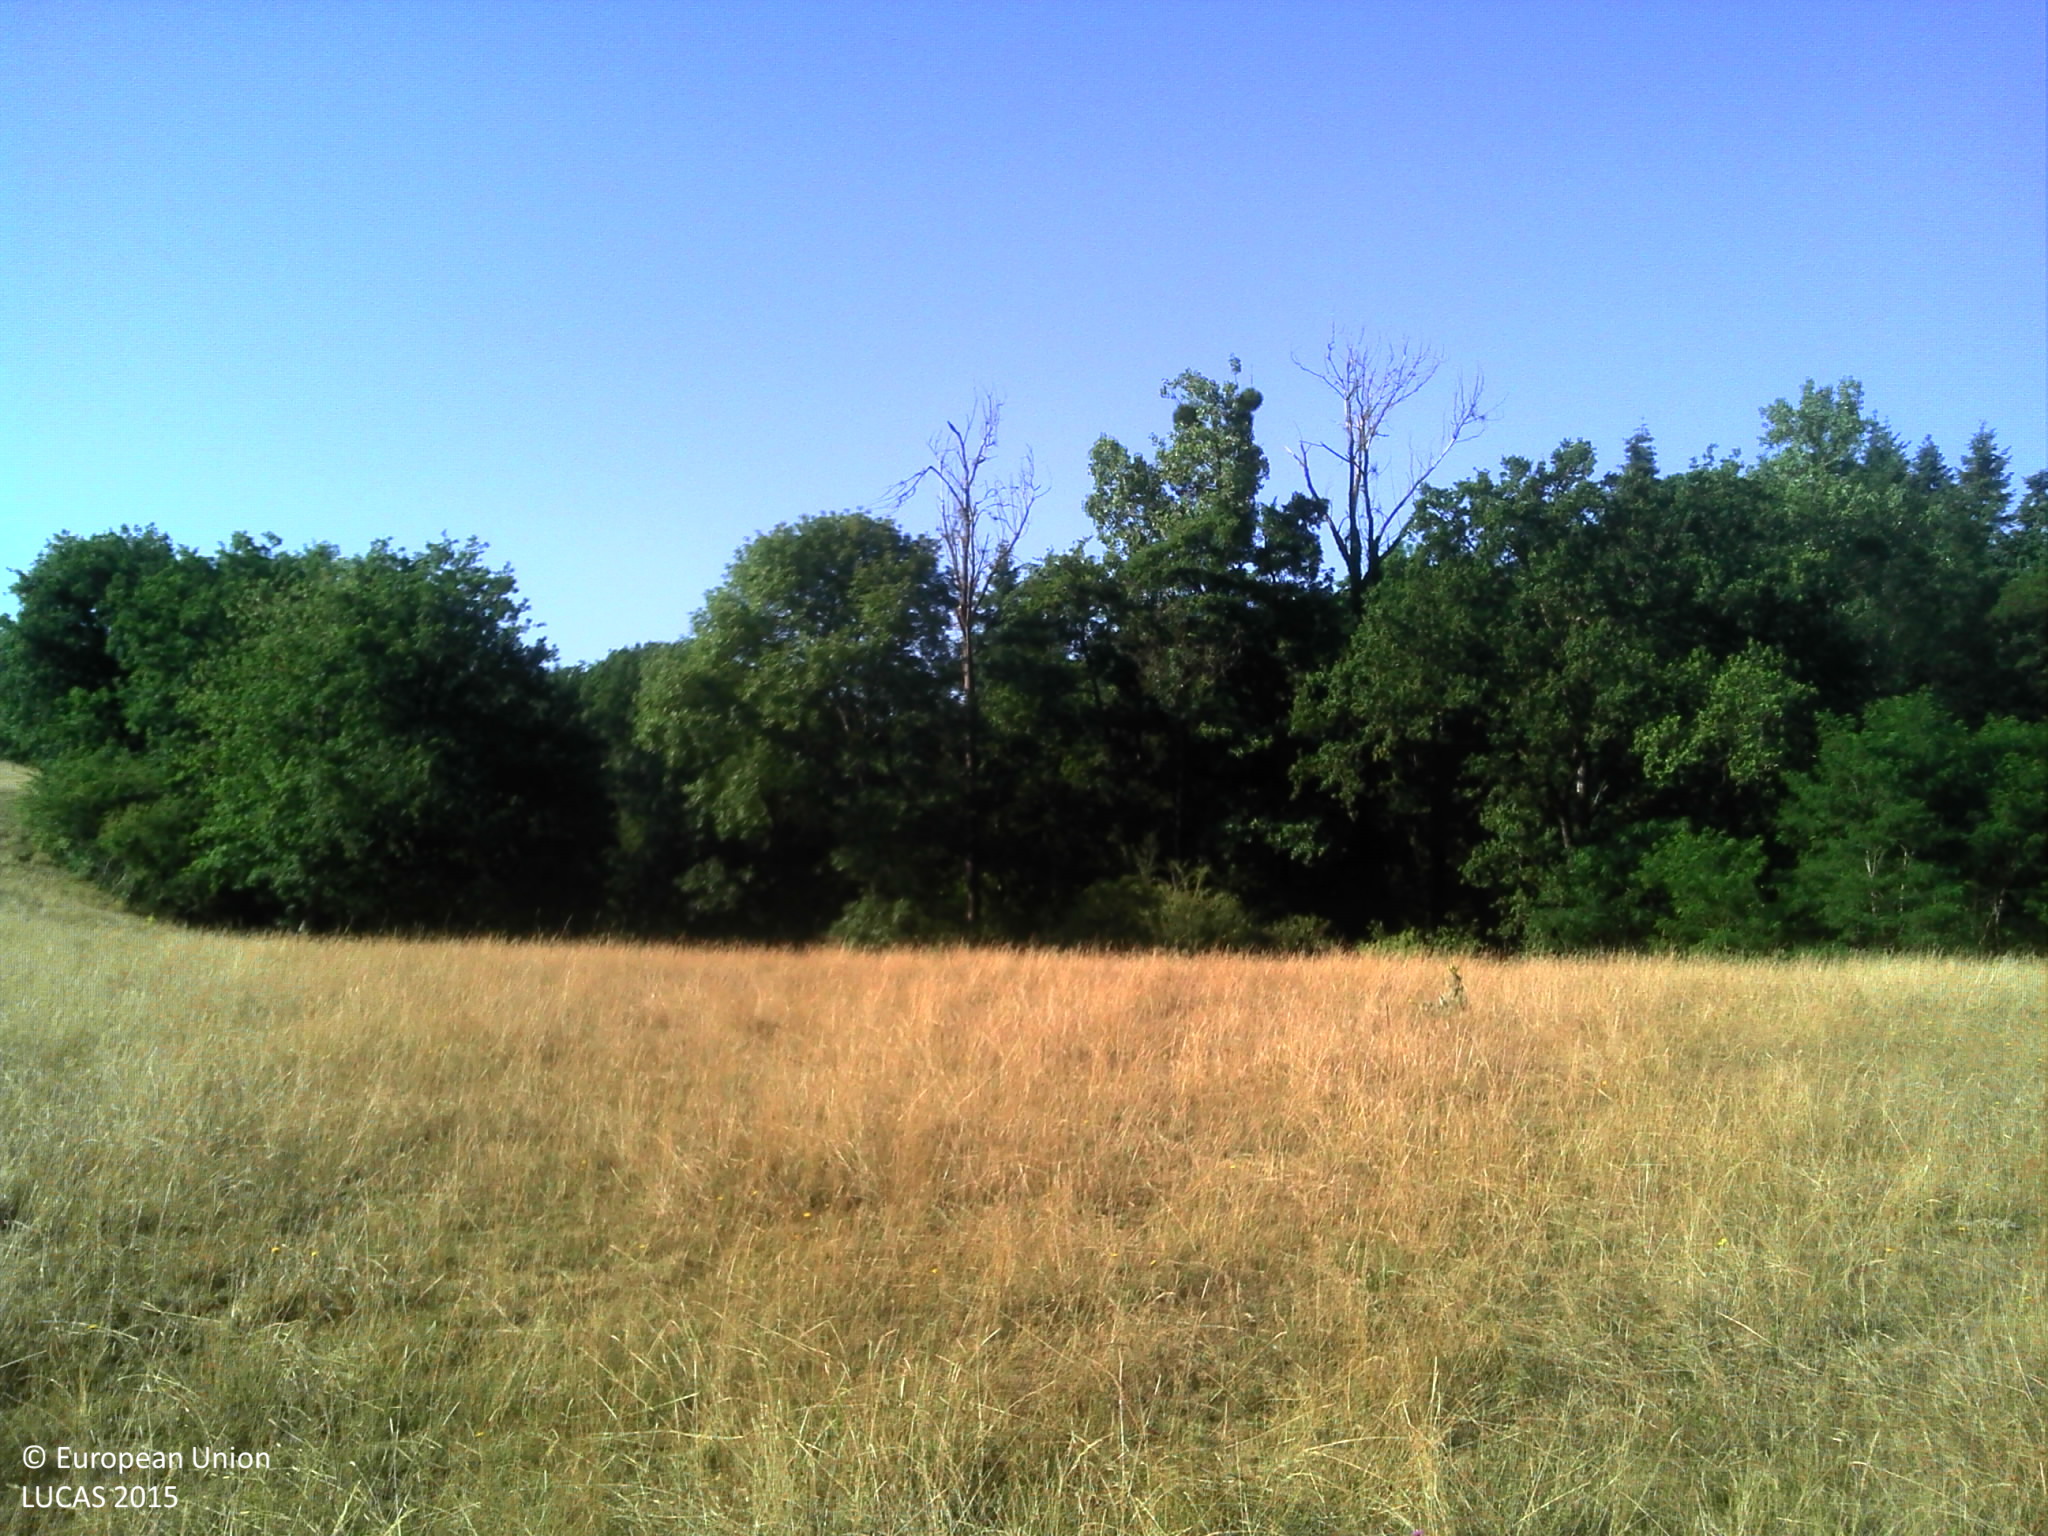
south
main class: Grassland
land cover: Grassland without tree/shrub cover
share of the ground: > 75 %
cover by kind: herbaceous plants 100 %
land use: Agriculture (excluding fallow land and kitchen gardens)
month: June
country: FR
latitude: 46.4055
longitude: 4.4471
